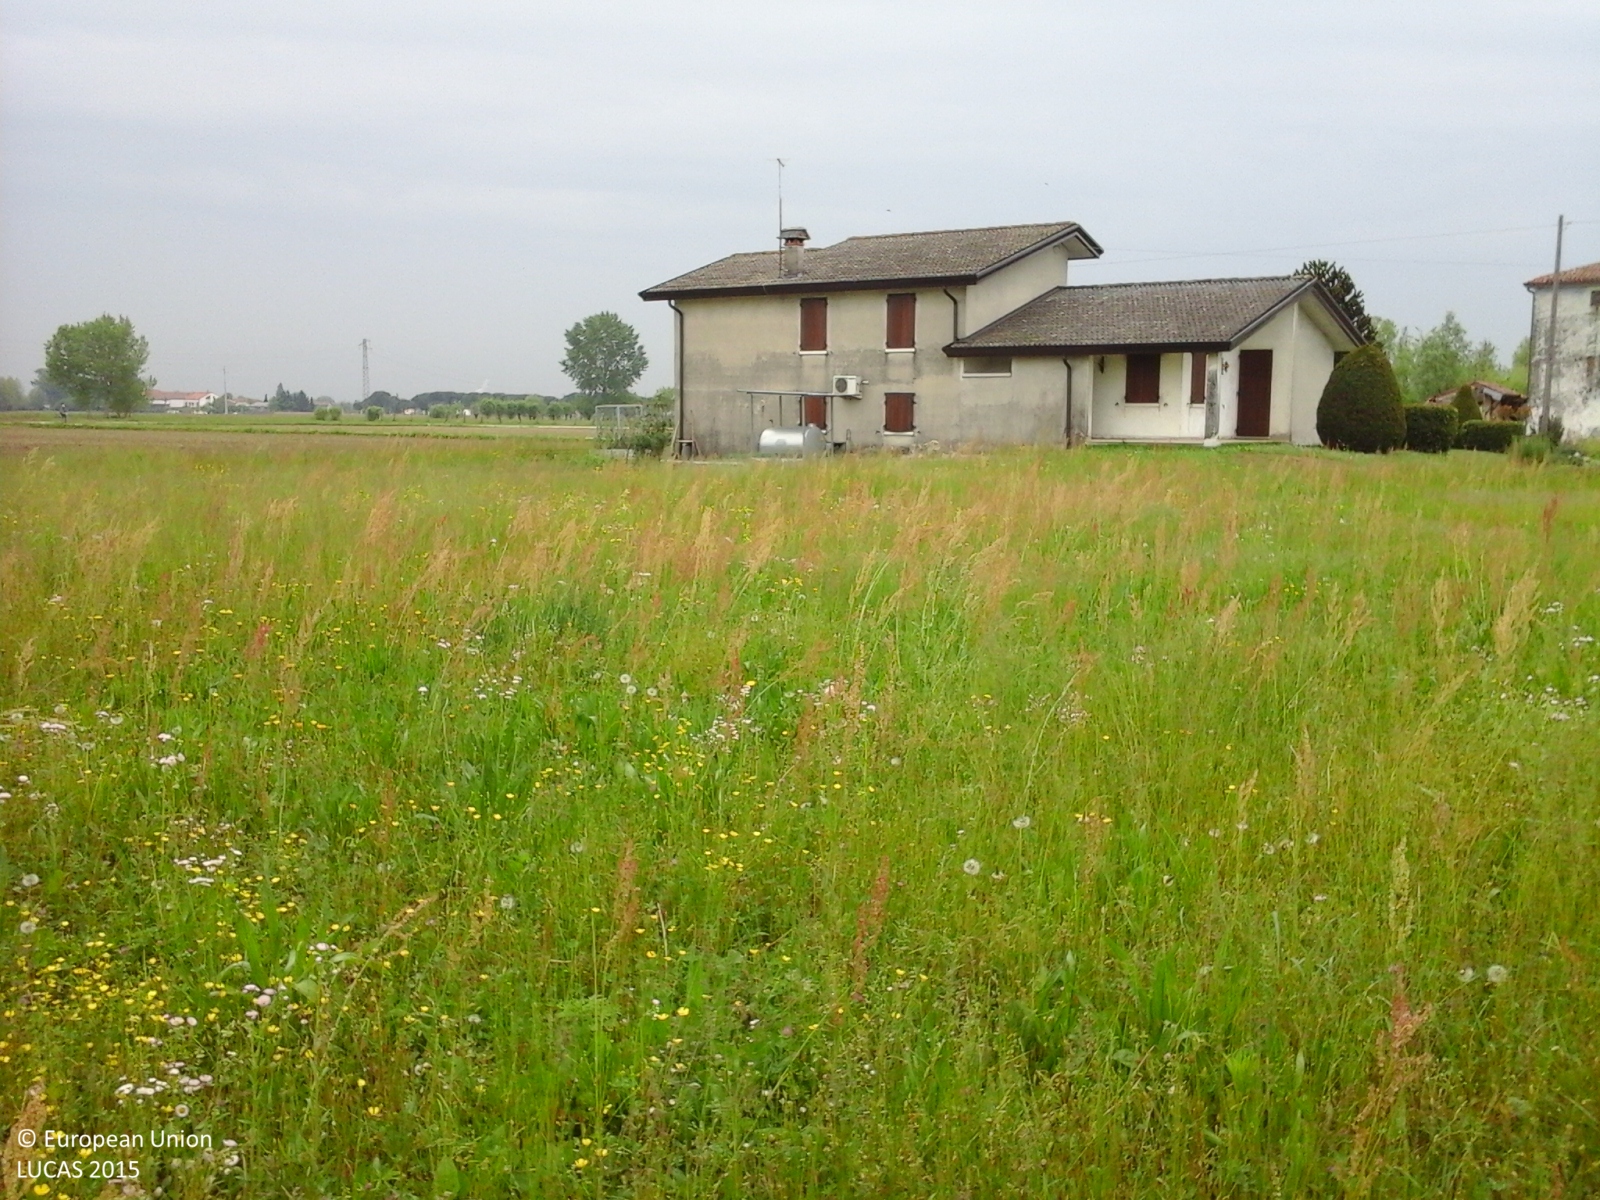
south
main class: Grassland
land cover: Grassland without tree/shrub cover
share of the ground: > 75 %
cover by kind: herbaceous plants 100 %
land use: Agriculture (excluding fallow land and kitchen gardens)
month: May
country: IT
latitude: 45.5448
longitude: 11.7007
